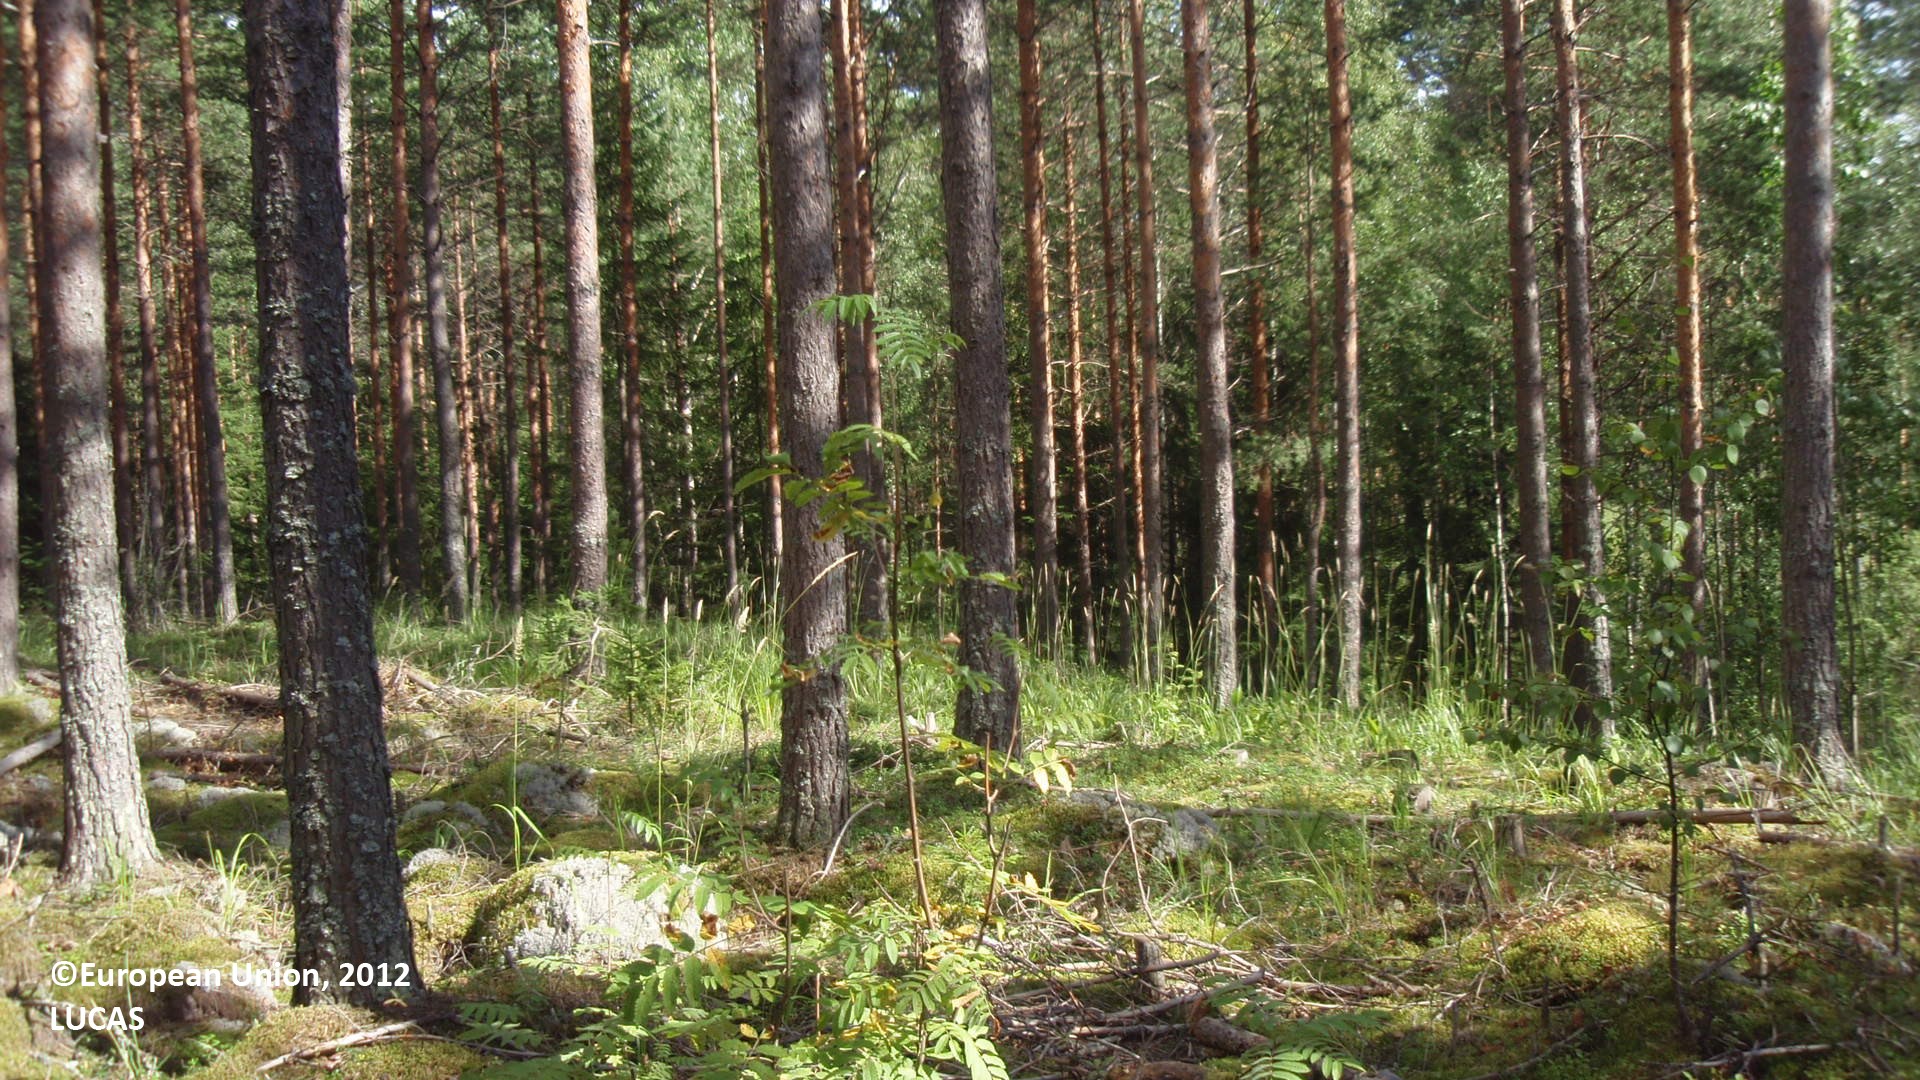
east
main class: Woodland
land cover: Pine dominated coniferous woodland
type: boreal forest
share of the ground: 50 - 75 %
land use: Forestry
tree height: > 5 m
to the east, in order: Pine dominated coniferous woodland; Pine dominated mixed woodland; Ditches and canals; Pine dominated mixed woodland; Ditches and canals; Pine dominated mixed woodland
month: August
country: FI
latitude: 61.1539
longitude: 27.7478
